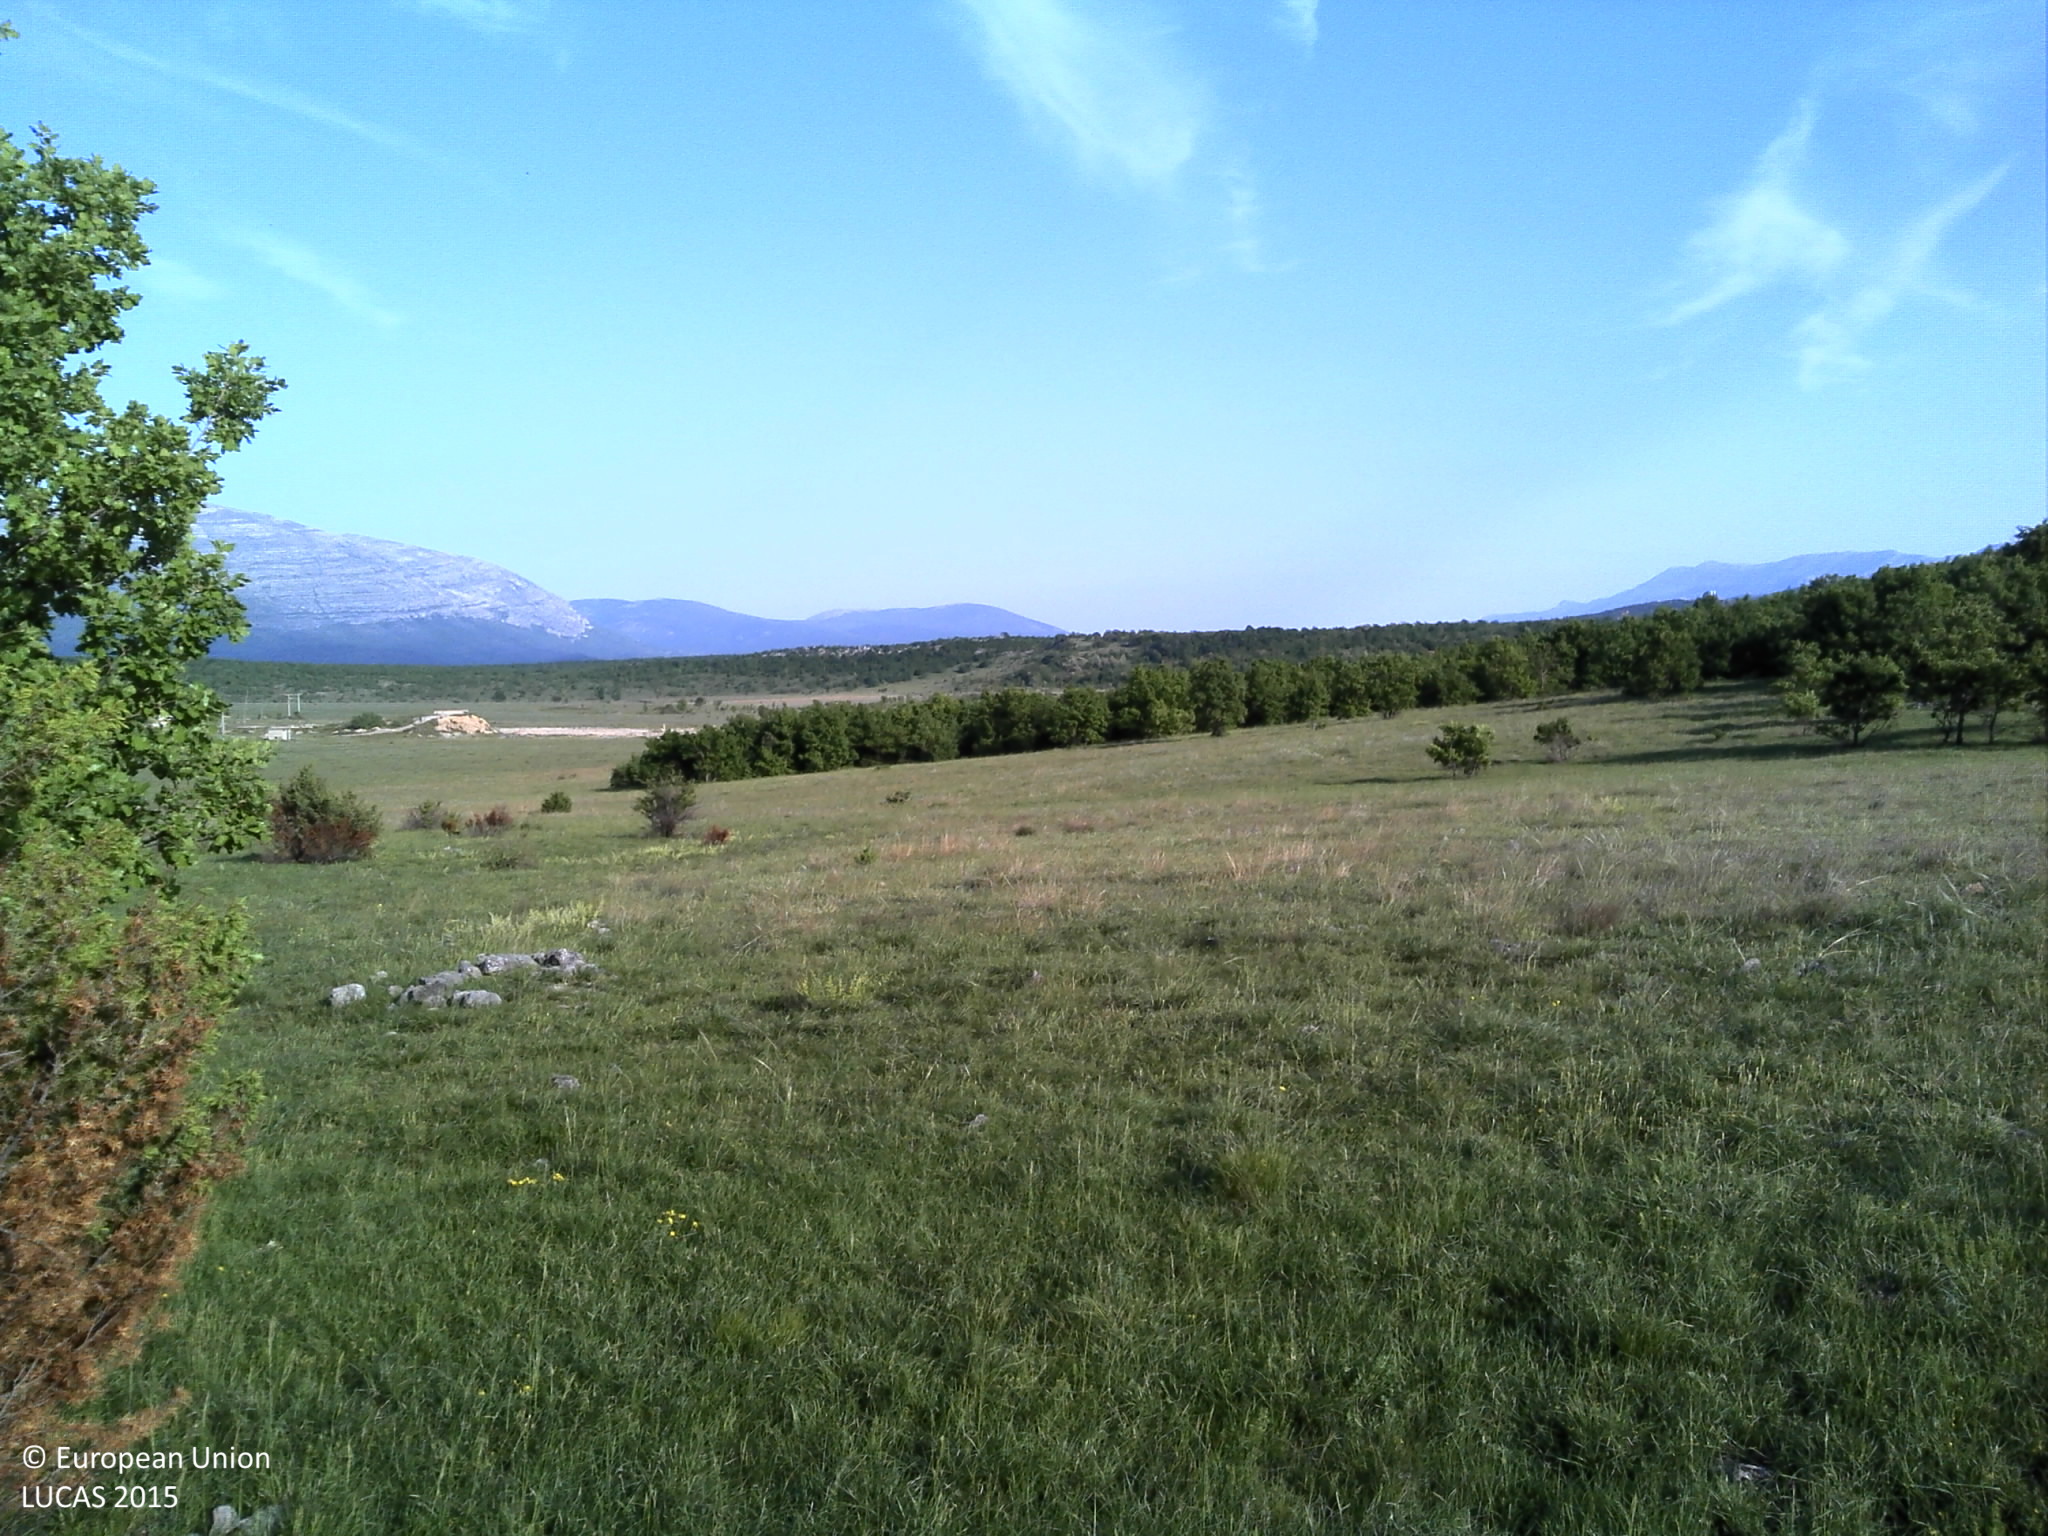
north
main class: Grassland
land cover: Grassland with sparse tree/shrub cover
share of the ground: > 75 %
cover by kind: herbaceous plants 85 %, shrubs 10 %, broadleaved forest trees 5 %
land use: Abandoned areas
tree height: < 5 m
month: May
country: HR
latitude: 44.0118
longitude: 16.3416
